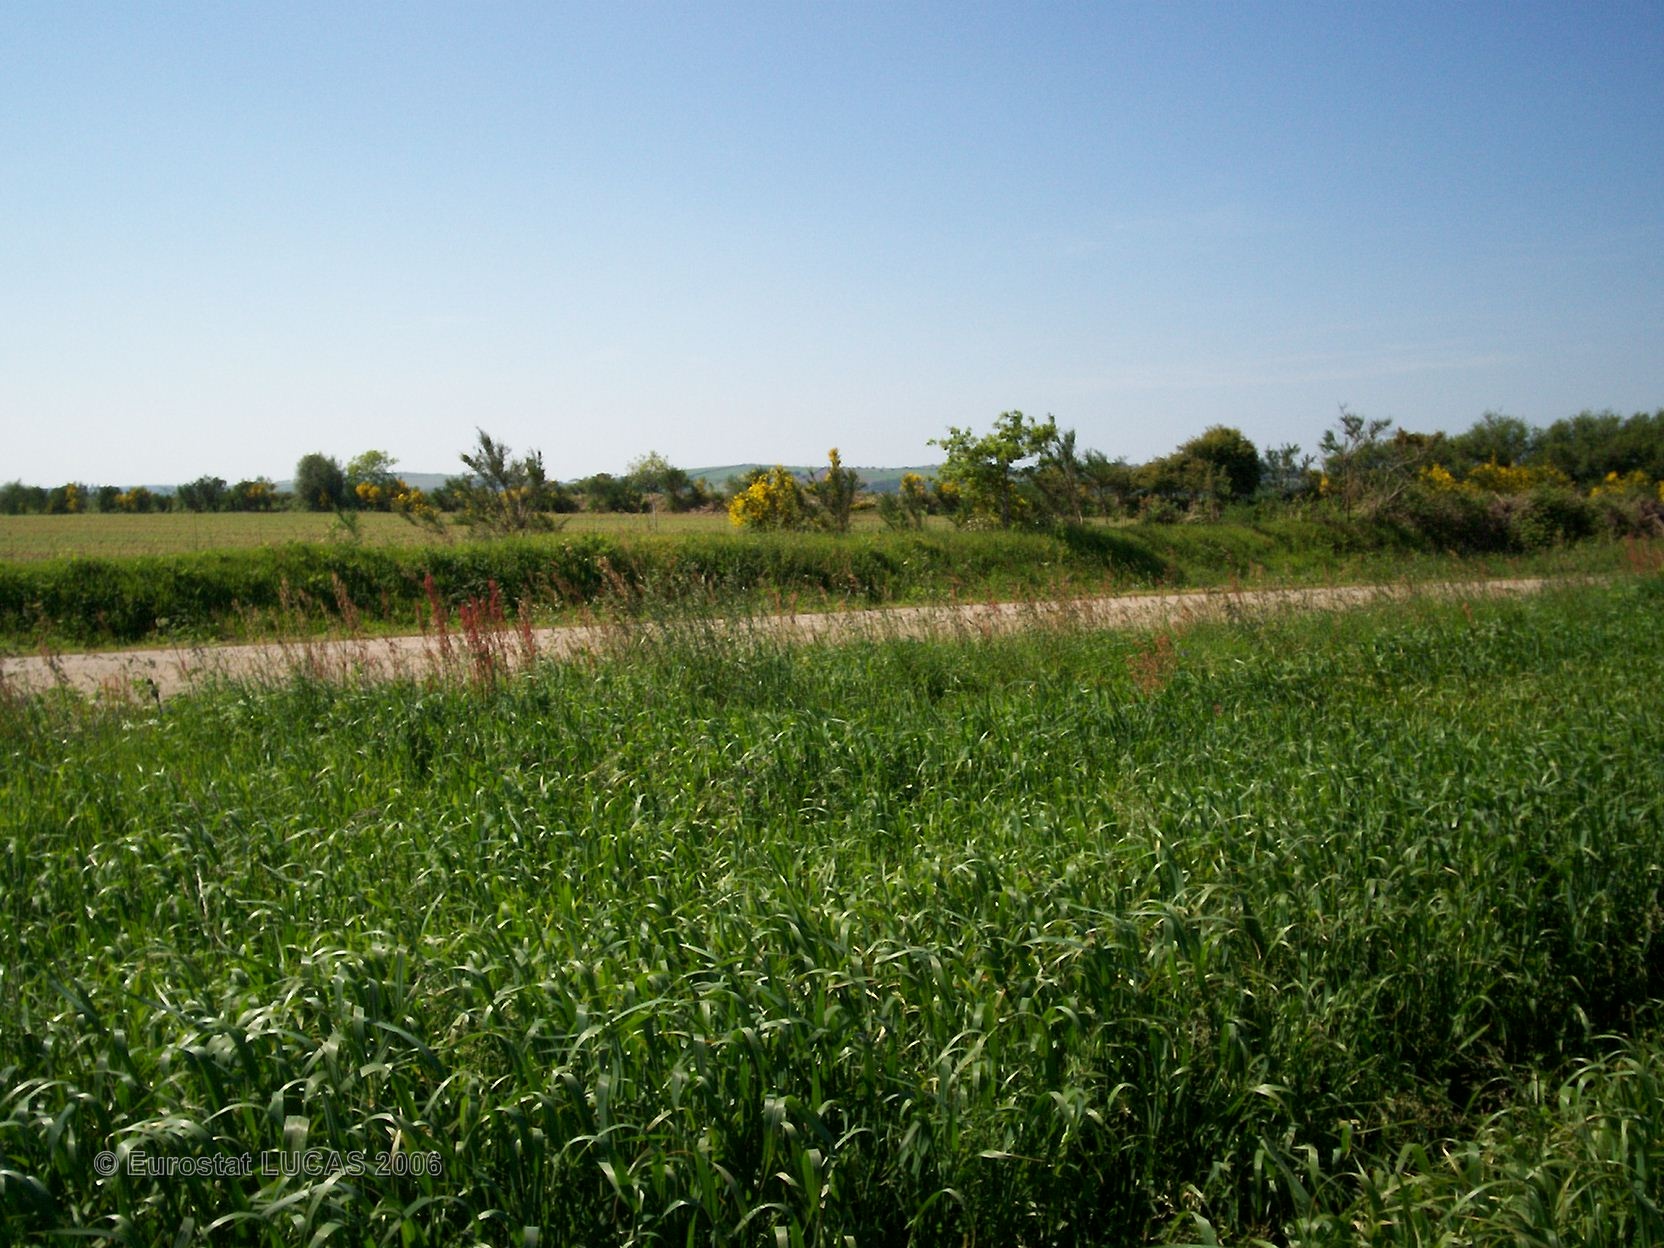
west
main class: Grassland
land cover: Grassland without tree/shrub cover
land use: Agriculture (excluding fallow land and kitchen gardens)
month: June
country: FR
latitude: 48.4648
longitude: -3.6465
